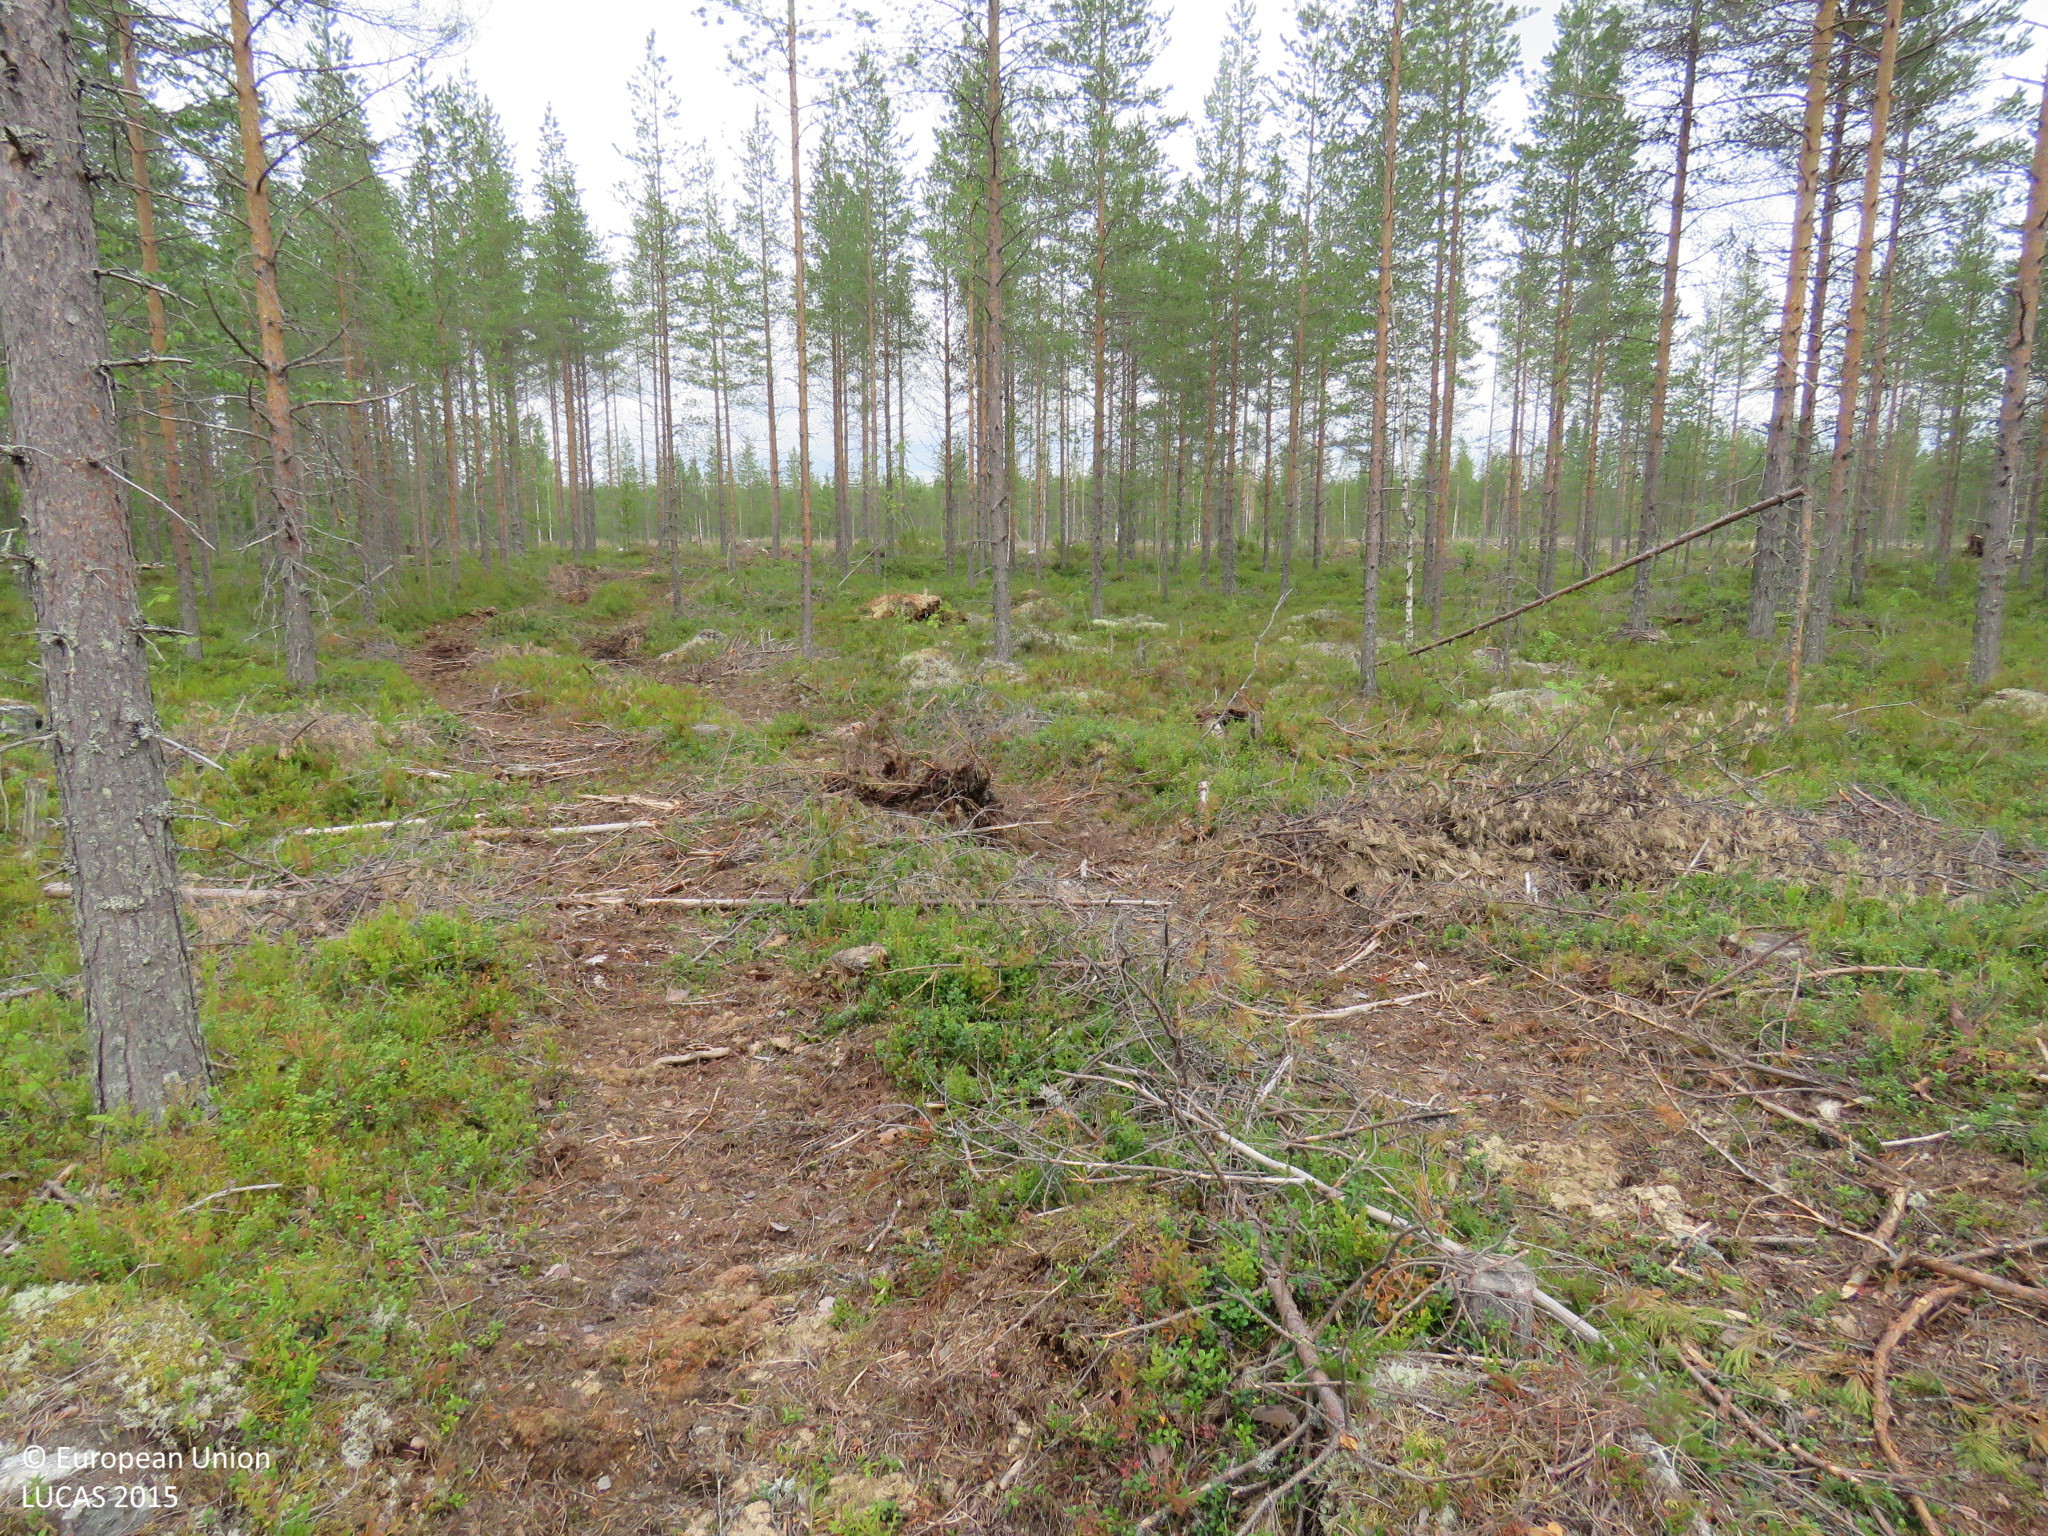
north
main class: Woodland
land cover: Pine dominated coniferous woodland
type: boreal forest
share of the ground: 50 - 75 %
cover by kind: coniferous forest trees 40 %, shrubs 40 %, broadleaved forest trees 10 %, lichens and mosses 10 %
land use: Forestry
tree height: > 5 m
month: July
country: FI
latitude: 64.6479
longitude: 26.9326
